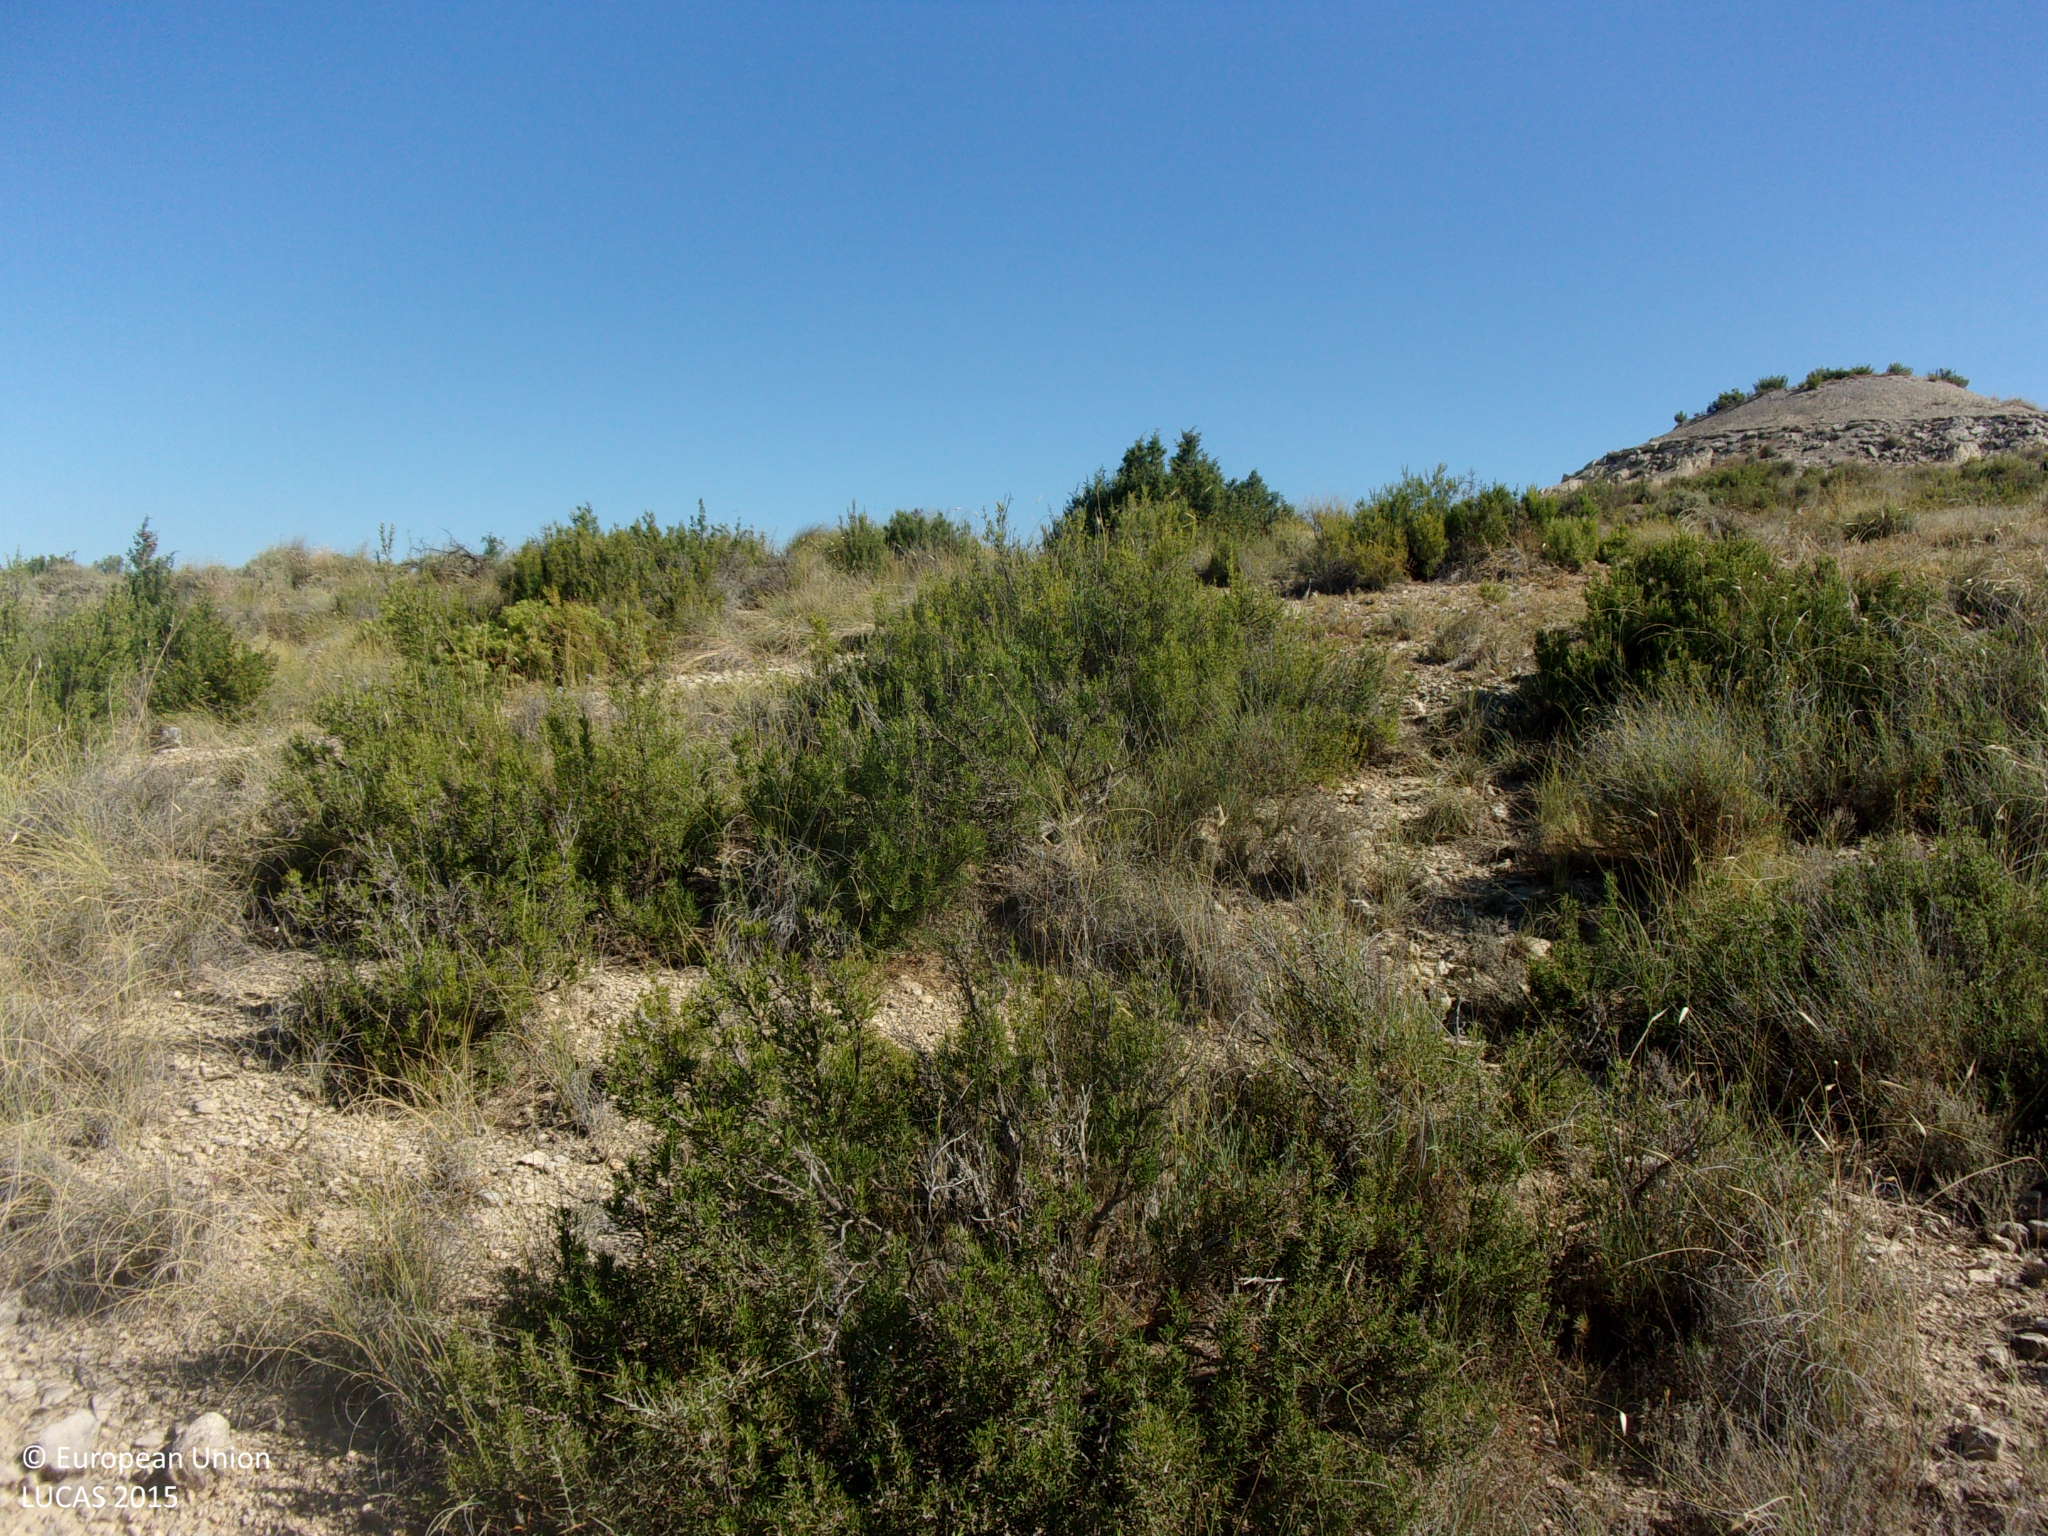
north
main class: Shrubland
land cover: Shrubland without tree cover
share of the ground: > 75 %
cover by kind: shrubs 75 %, unconsolidated bare surface 25 %
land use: Semi-natural and natural areas not in use
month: July
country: ES
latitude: 42.0646
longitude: -1.0606
